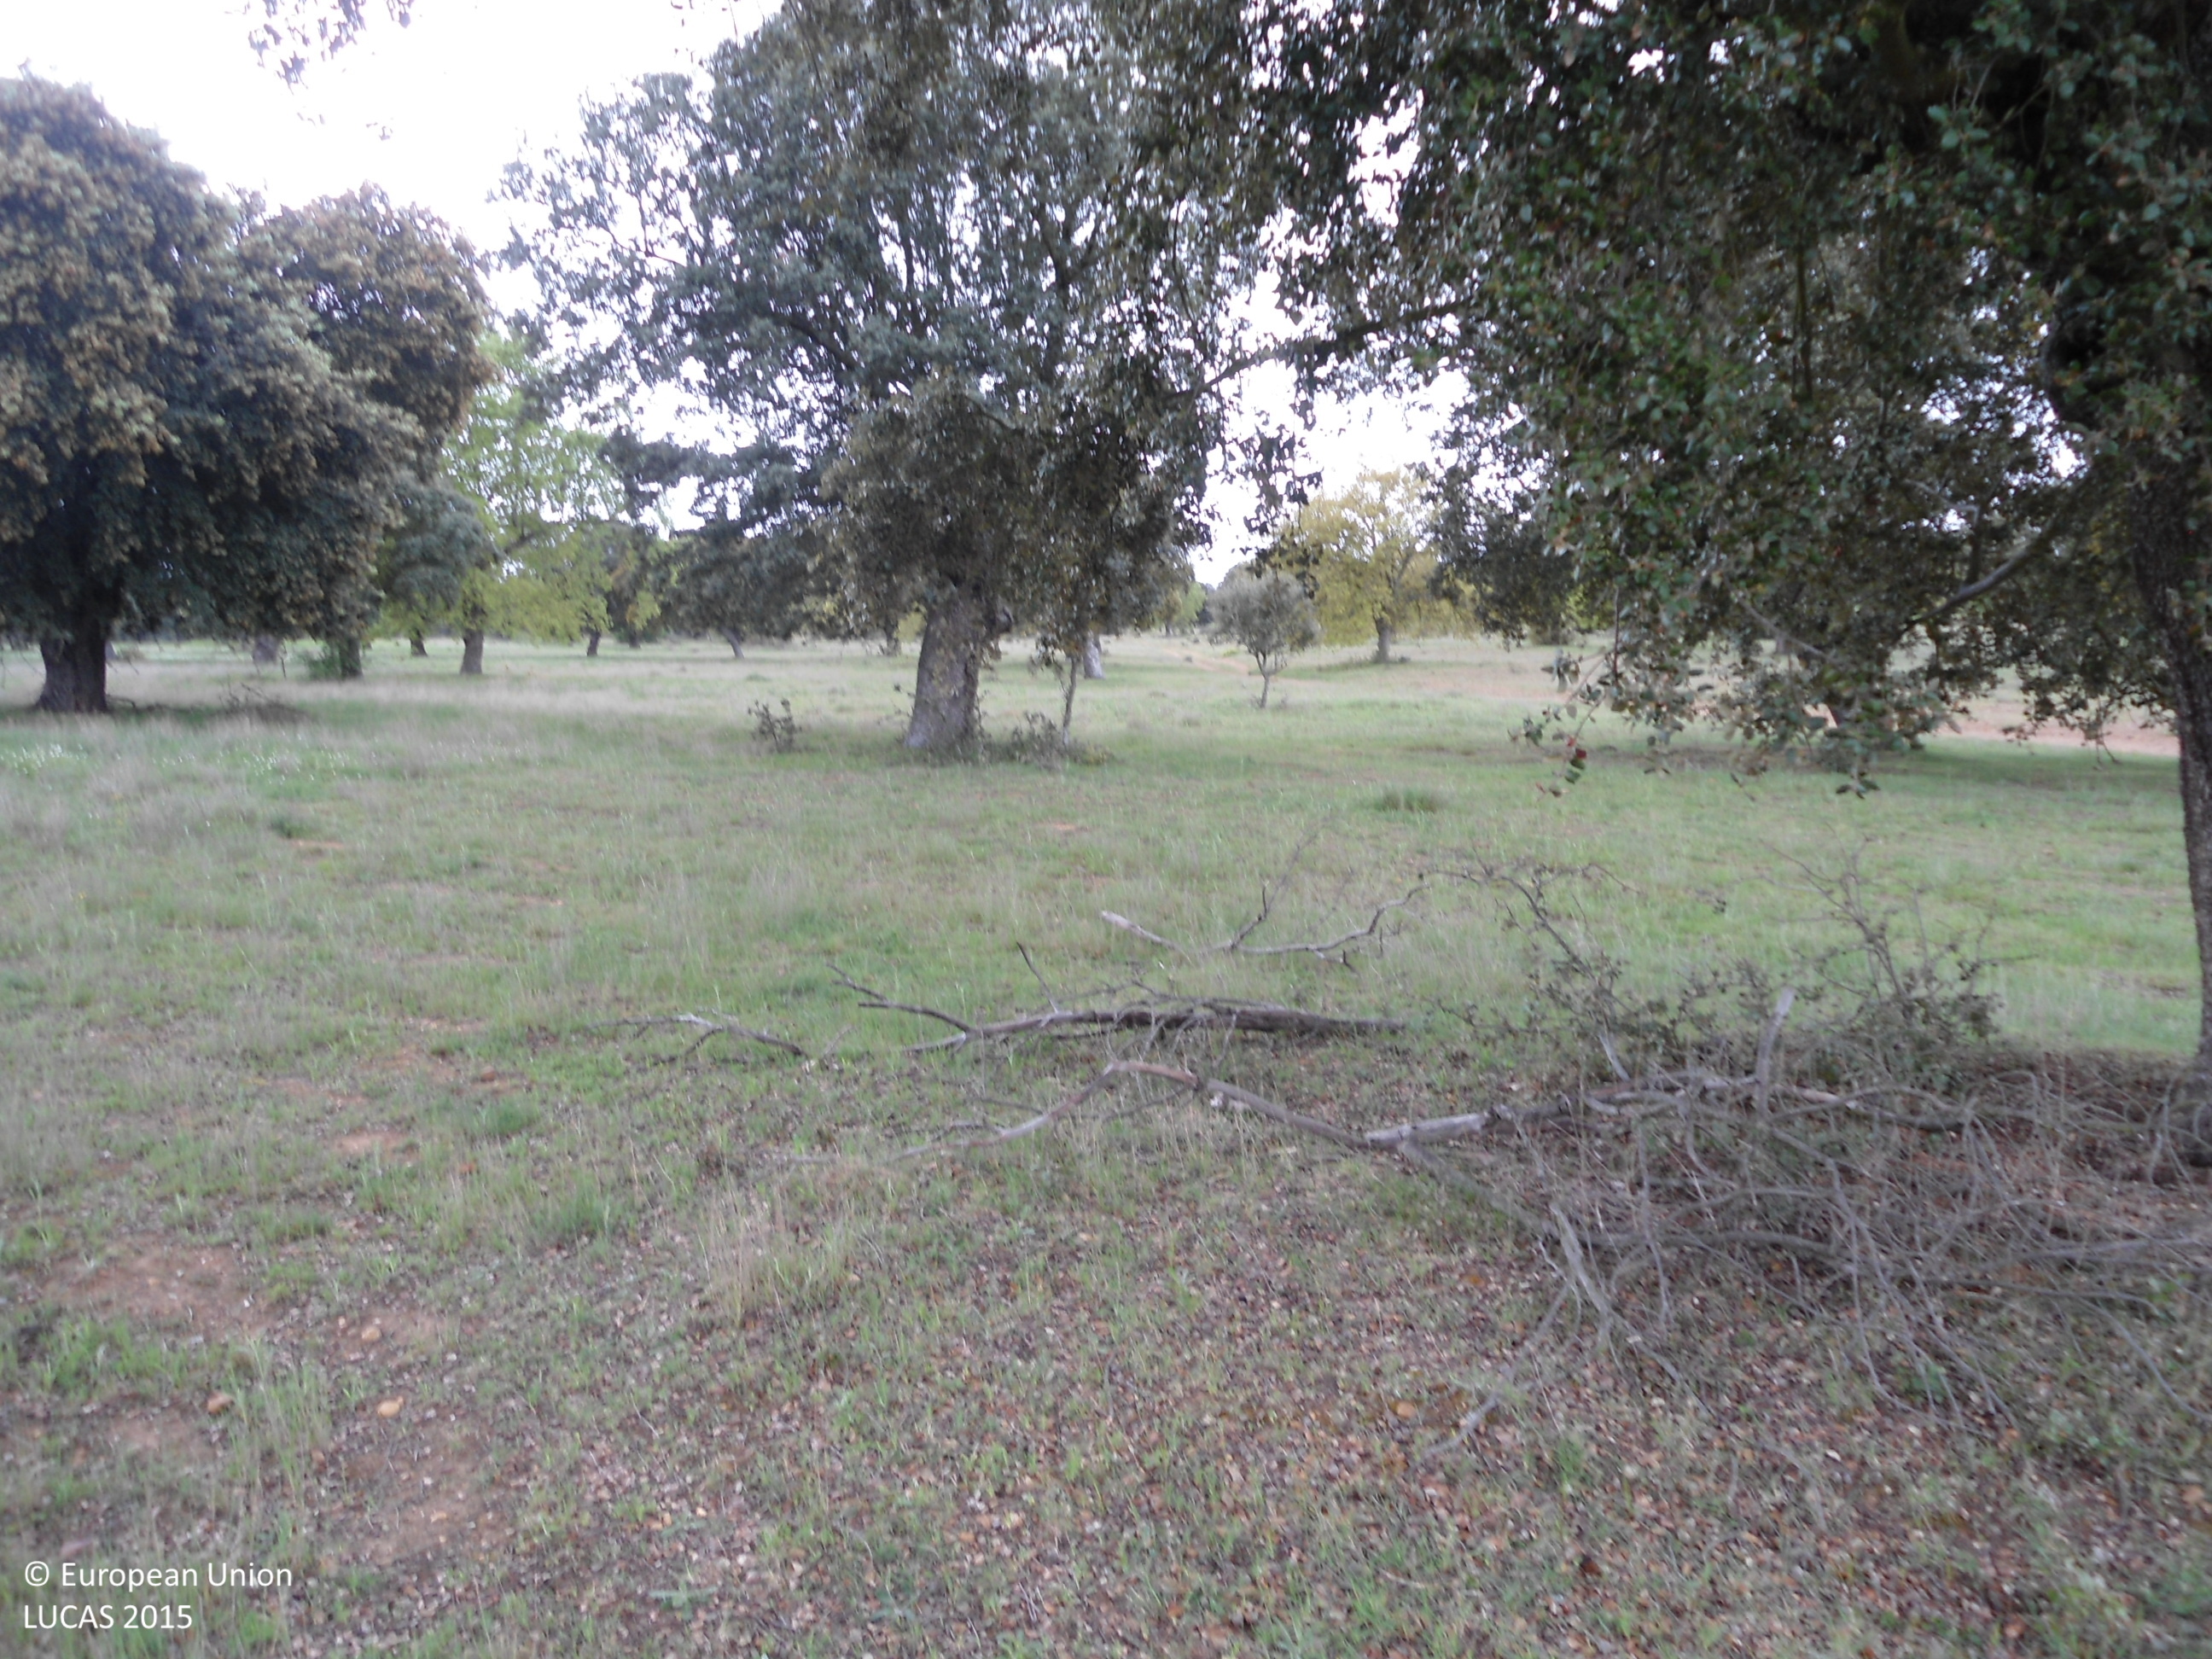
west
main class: Woodland
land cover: Broadleaved woodland
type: broadleaved evergreen forest
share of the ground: 25 - 50 %
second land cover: Grassland without tree/shrub cover
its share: 50 - 75 %
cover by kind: herbaceous plants 55 %, broadleaved forest trees 40 %, shrubs 5 %
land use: Forestry
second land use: Agriculture (excluding fallow land and kitchen gardens)
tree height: > 5 m
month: May
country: ES
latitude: 41.8114
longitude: -5.8989
